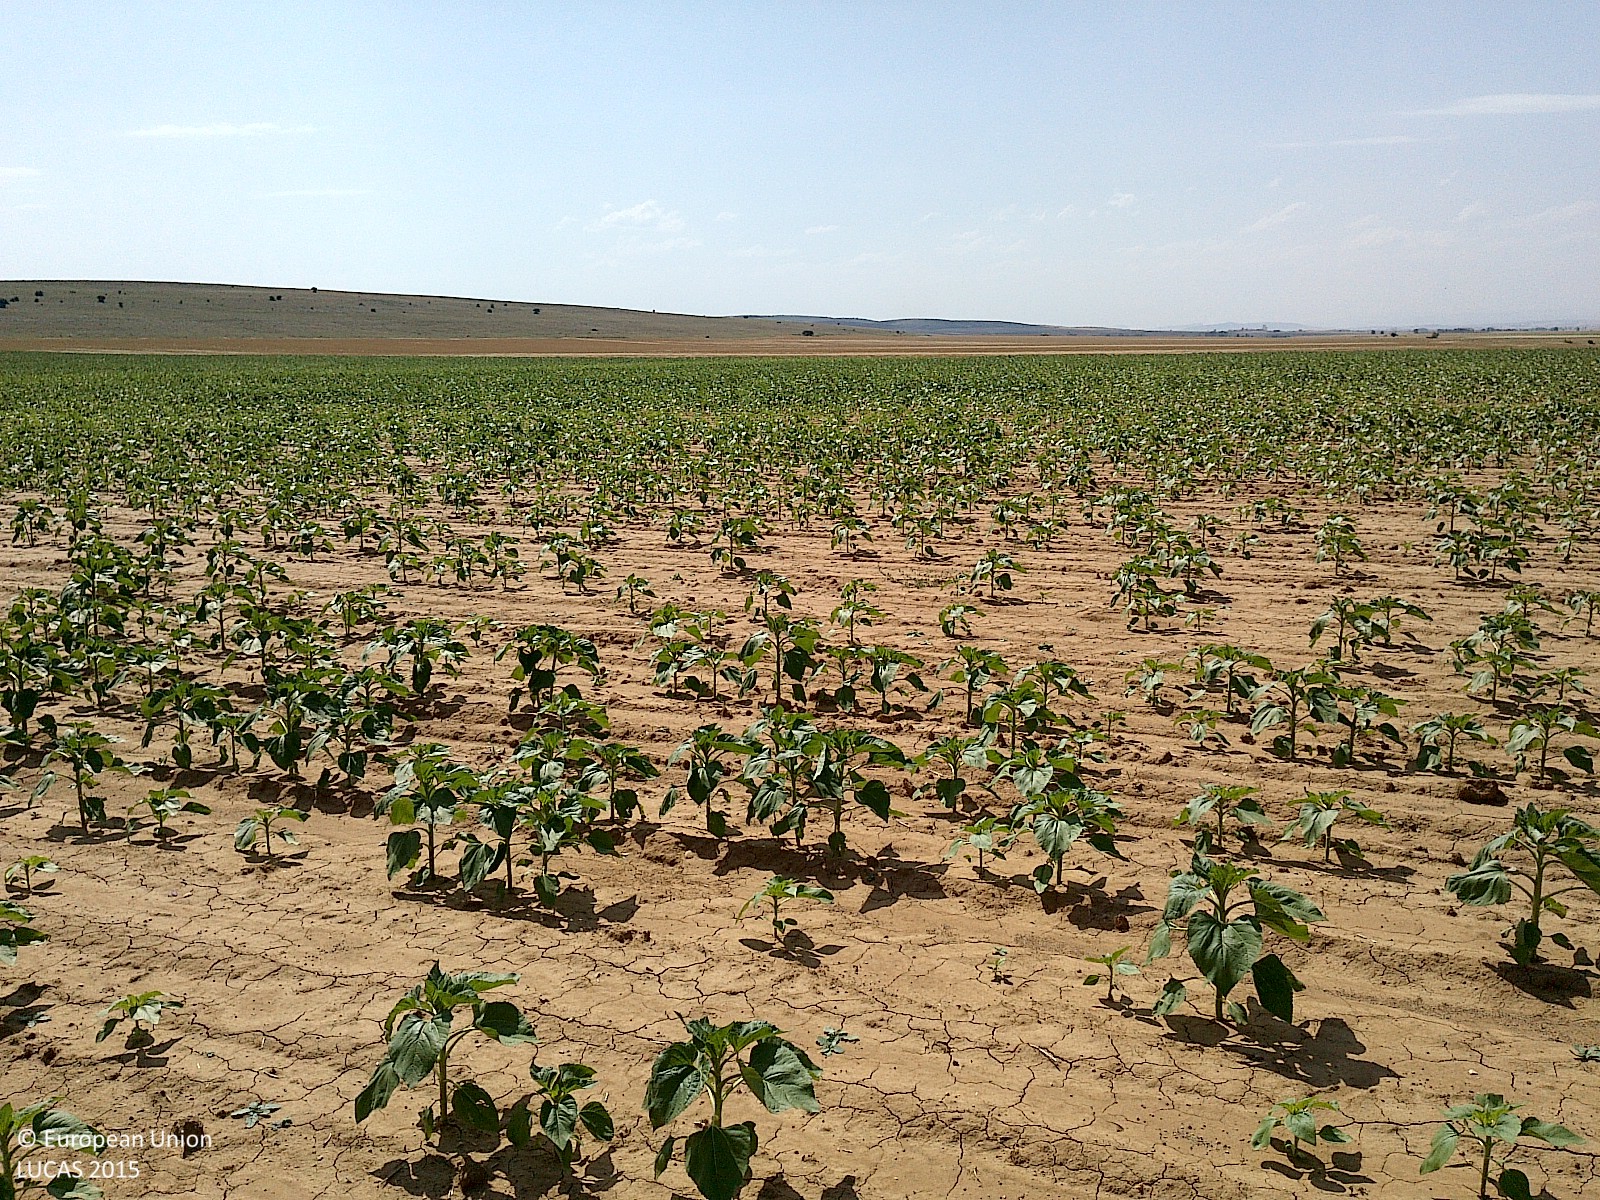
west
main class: Cropland
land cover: Sunflower
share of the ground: < 10 %
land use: Agriculture (excluding fallow land and kitchen gardens)
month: July
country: ES
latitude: 41.6135
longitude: -2.1170
